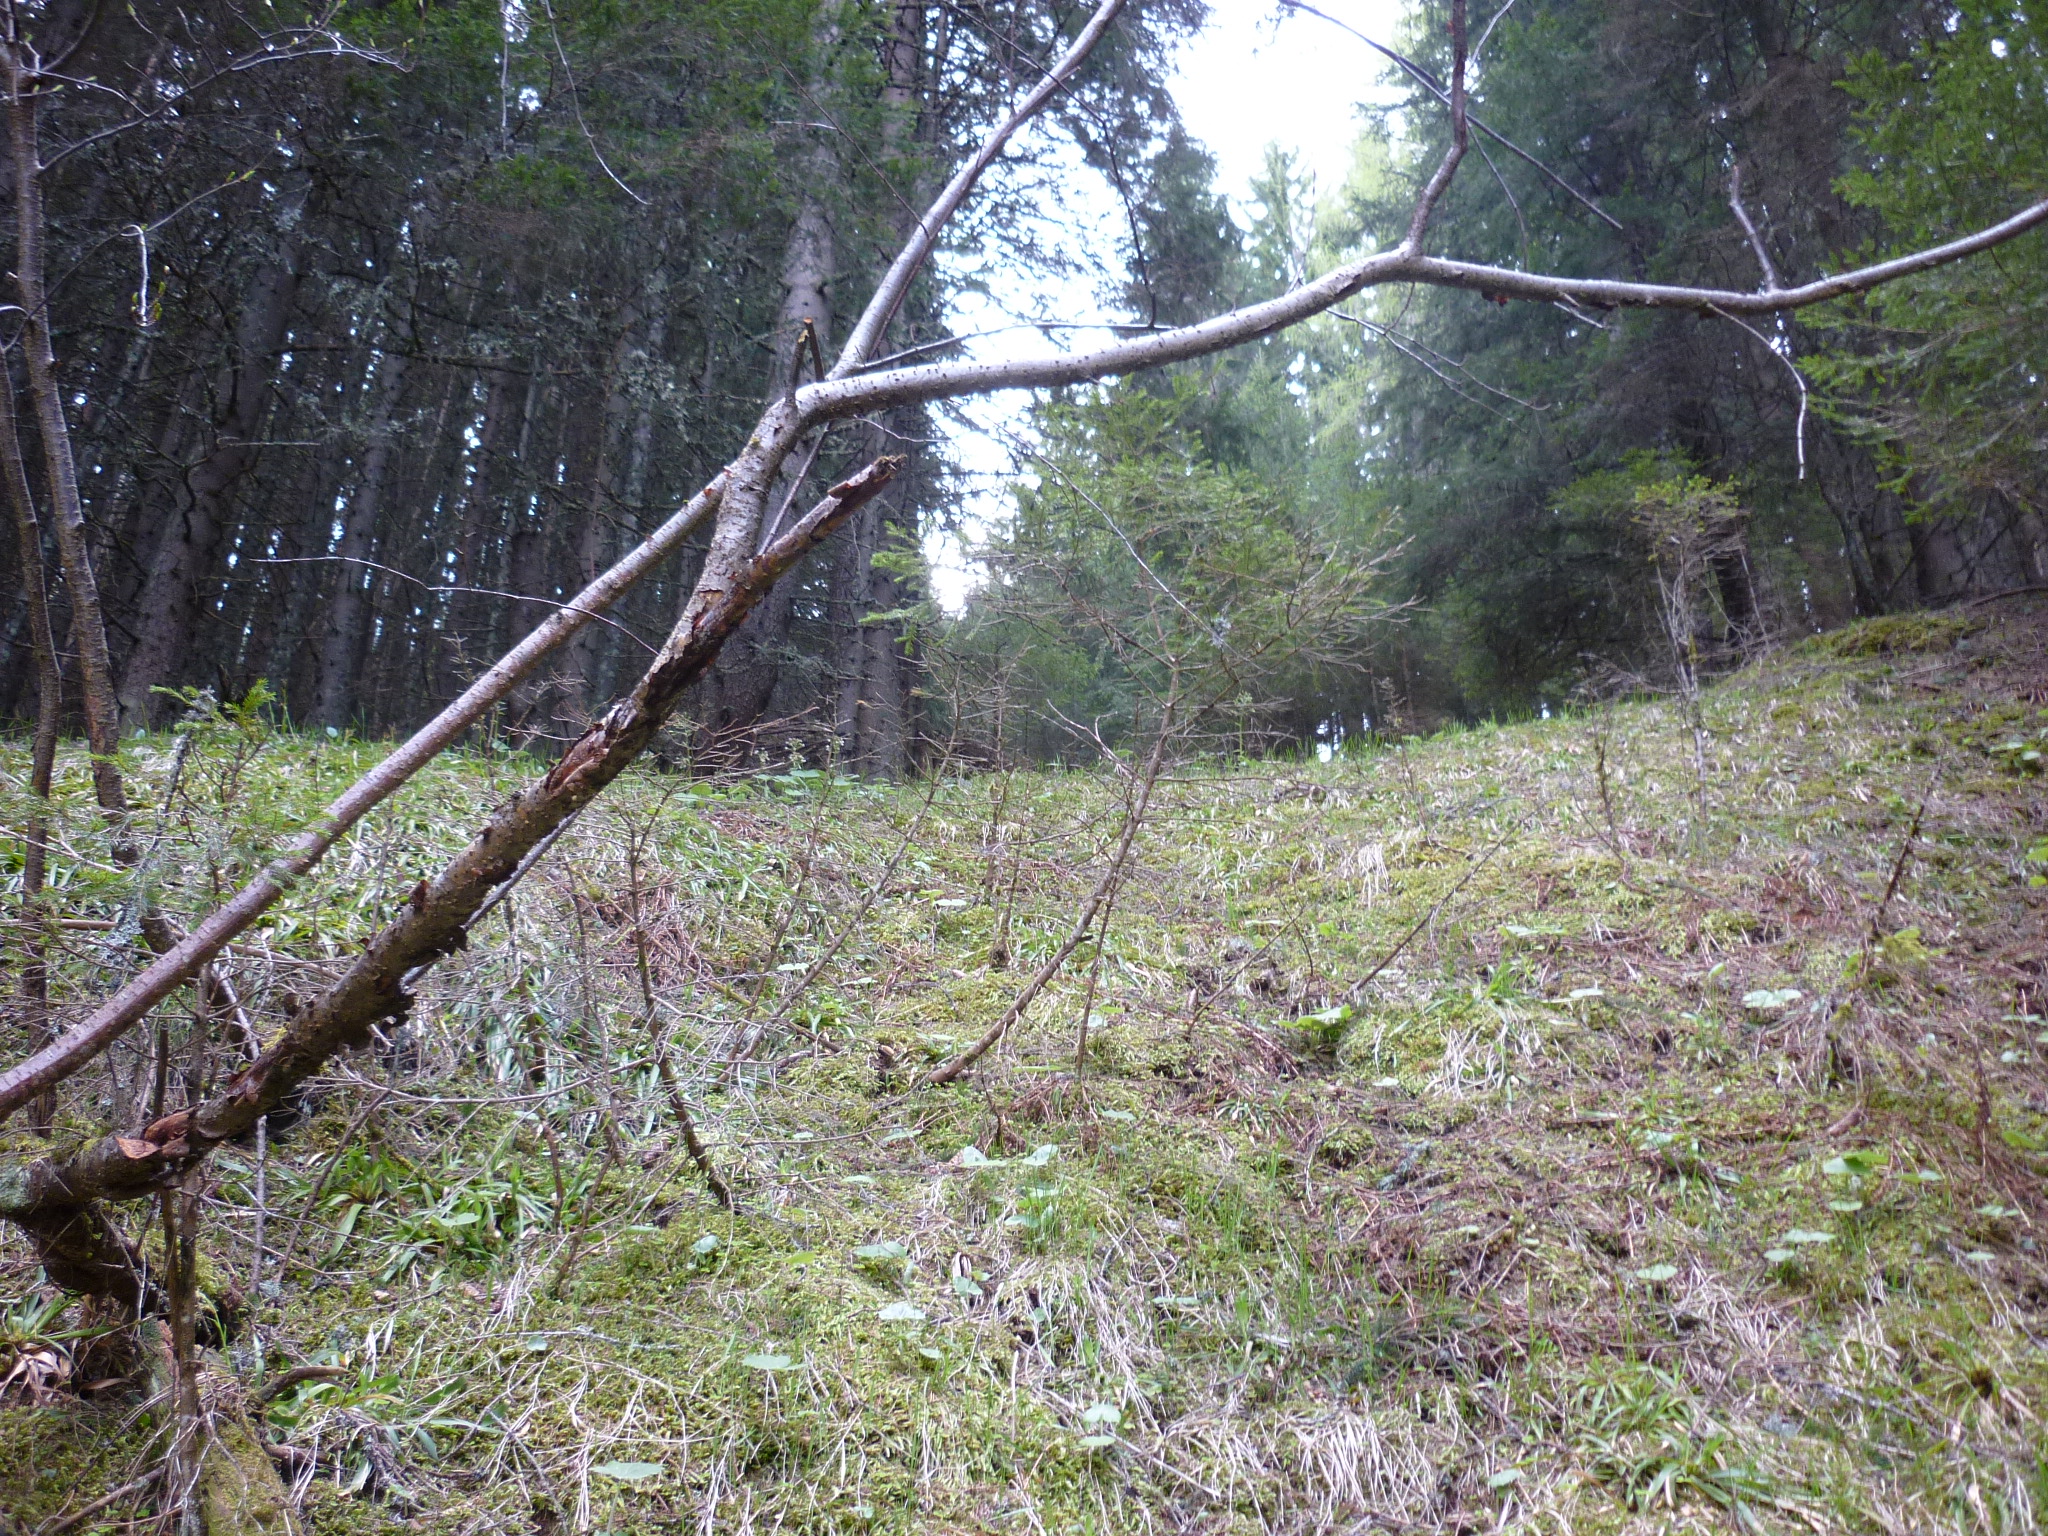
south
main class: Grassland
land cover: Grassland with sparse tree/shrub cover
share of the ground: > 75 %
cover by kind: herbaceous plants 90 %, coniferous forest trees 5 %, lichens and mosses 5 %
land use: Forestry
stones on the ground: 10 - 25 %
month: May
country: AT
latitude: 47.5062
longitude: 14.3671
